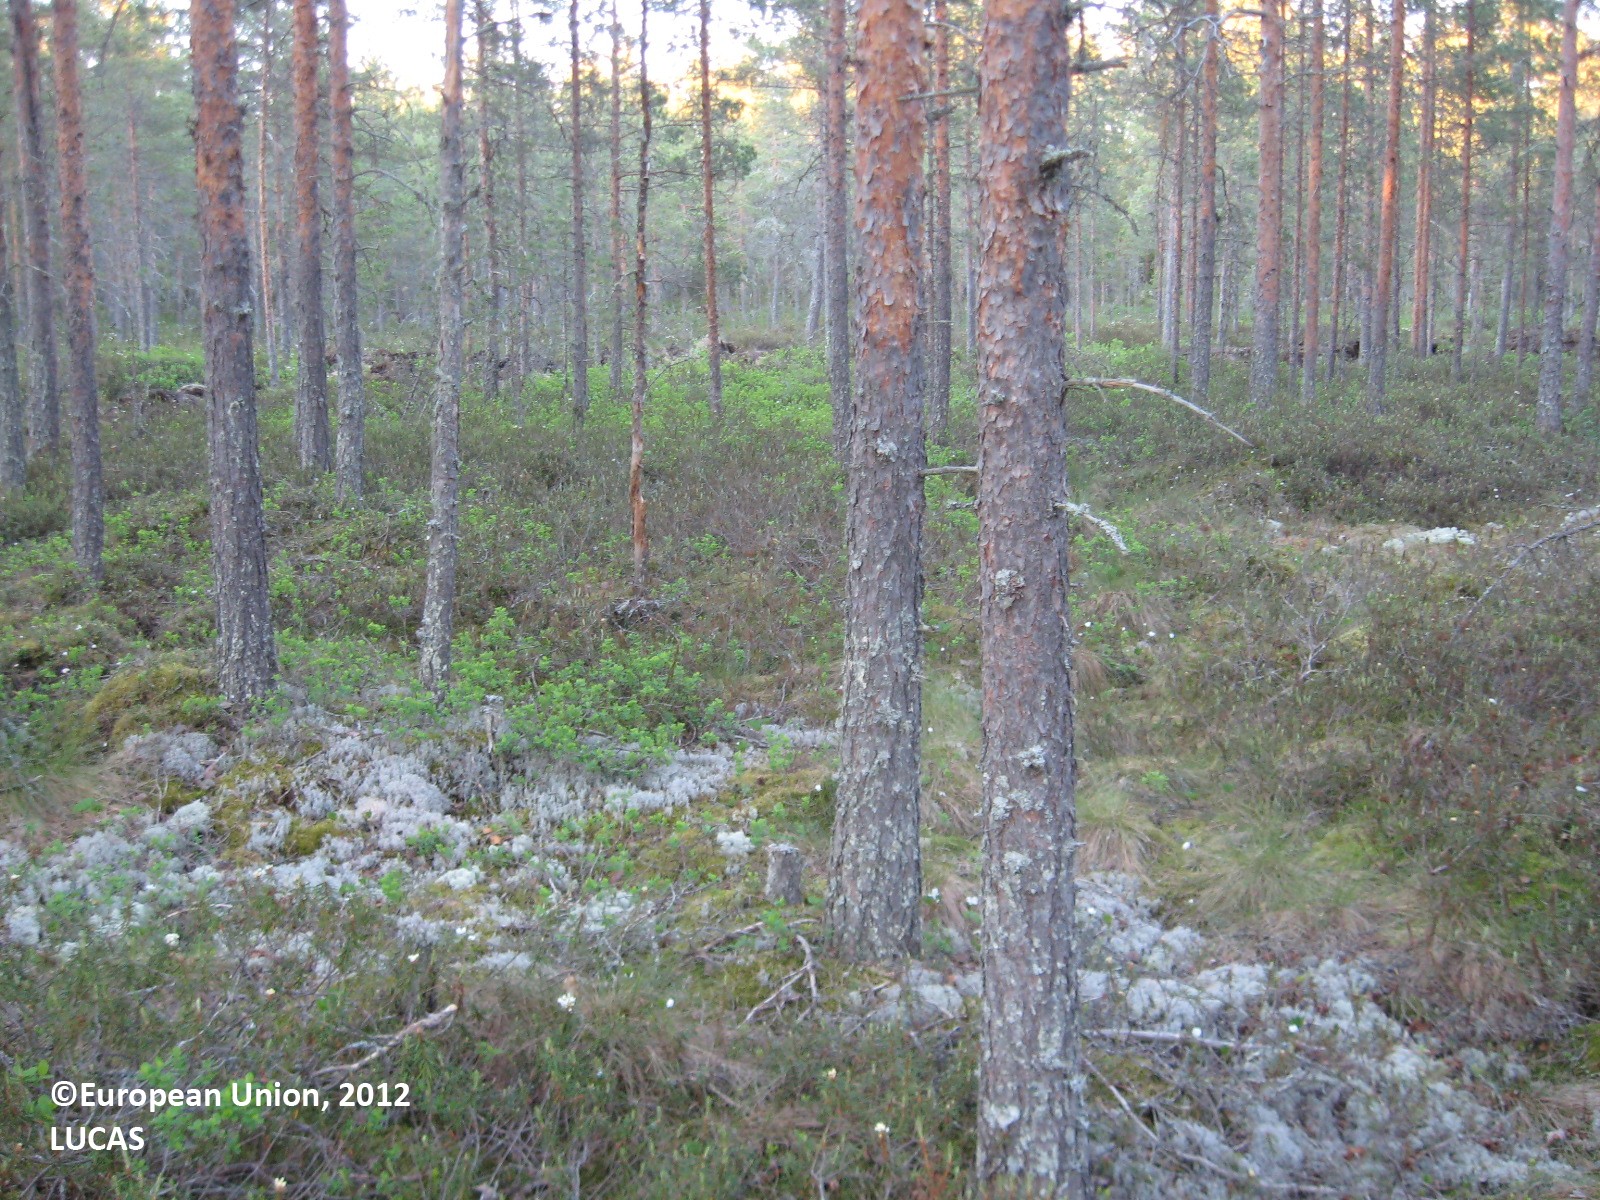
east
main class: Woodland
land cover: Pine dominated coniferous woodland
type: boreal forest
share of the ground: 50 - 75 %
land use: Forestry
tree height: > 5 m
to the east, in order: Pine dominated coniferous woodland; Ditches and canals; Pine dominated coniferous woodland; Ditches and canals; Pine dominated coniferous woodland
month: June
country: FI
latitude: 63.2589
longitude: 22.7418
